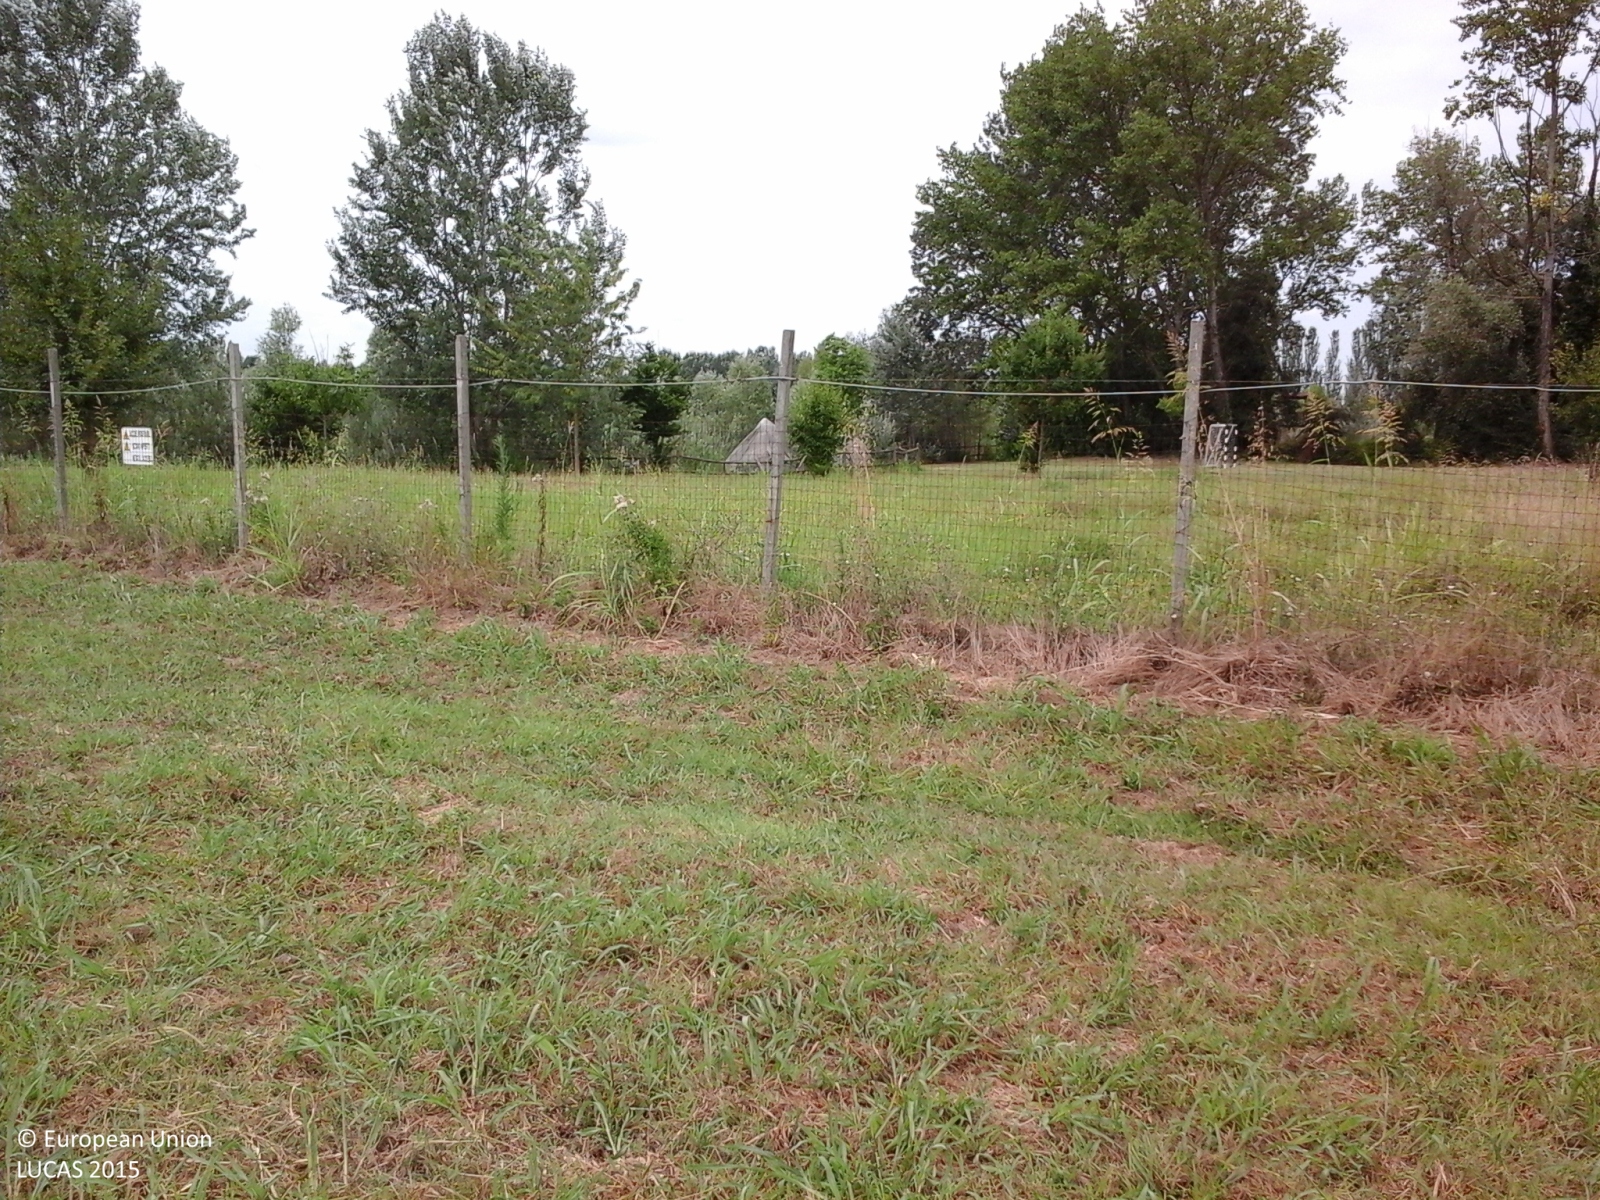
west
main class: Grassland
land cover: Grassland without tree/shrub cover
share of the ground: > 75 %
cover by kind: herbaceous plants 100 %
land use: Agriculture (excluding fallow land and kitchen gardens)
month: July
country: IT
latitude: 44.8623
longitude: 11.5283
